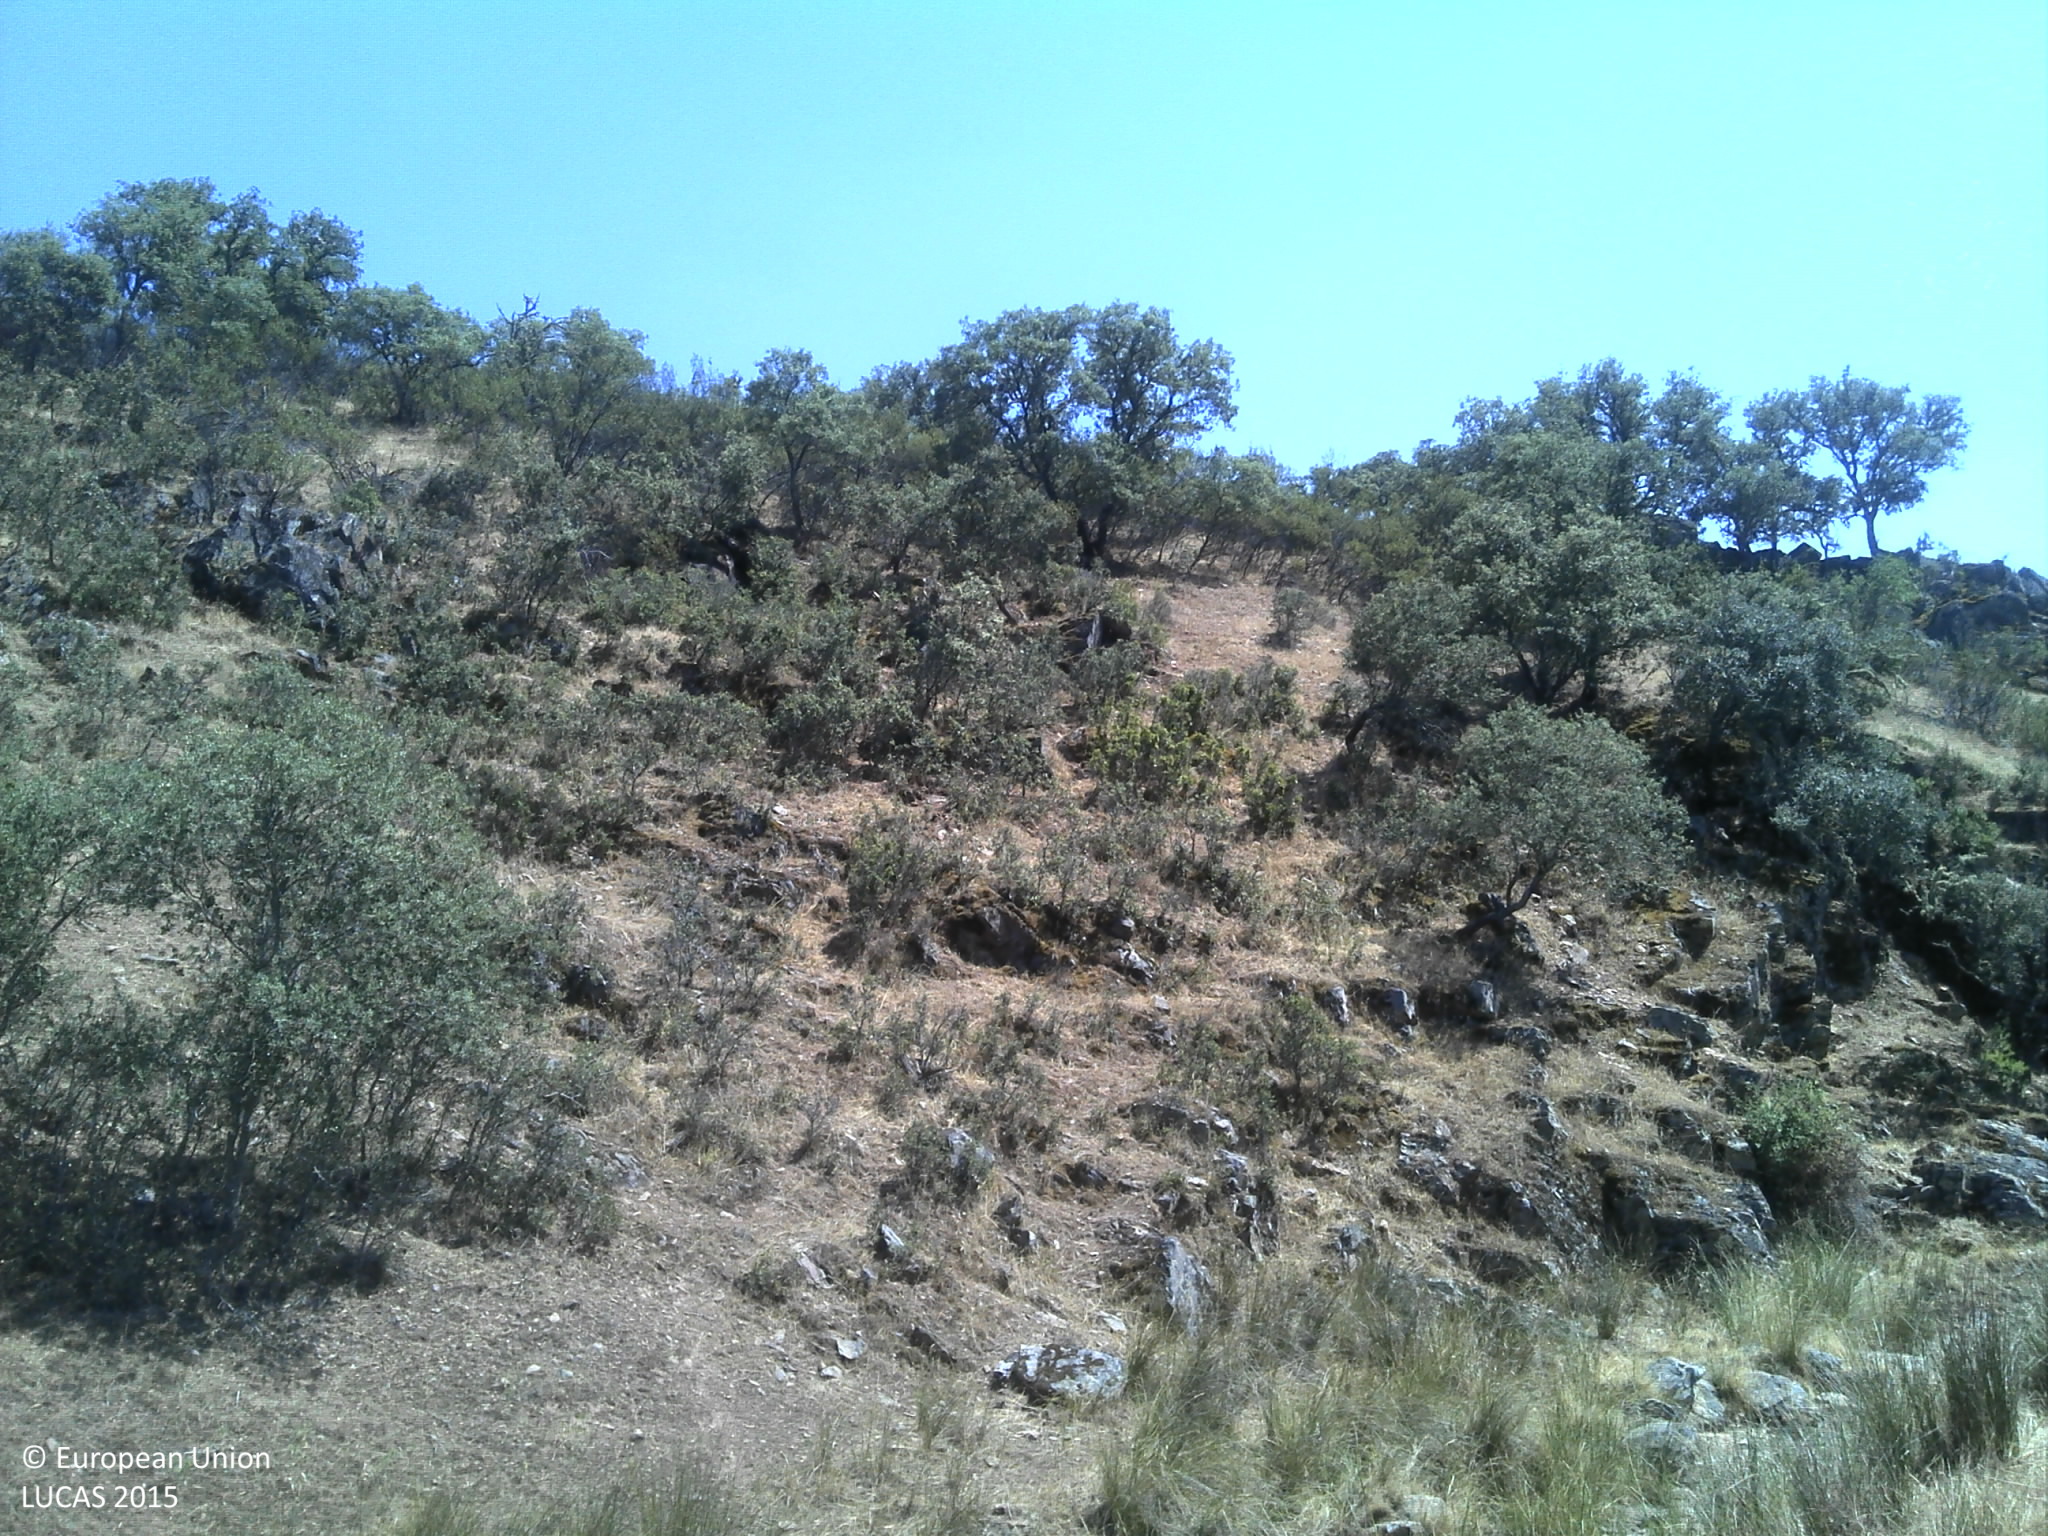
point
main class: Shrubland
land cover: Shrubland with sparse tree cover
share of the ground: 50 - 75 %
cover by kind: shrubs 55 %, herbaceous plants 25 %, unconsolidated bare surface 10 %, broadleaved forest trees 5 %
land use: Forestry
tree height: > 5 m
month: June
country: PT
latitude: 39.6722
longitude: -7.1195
